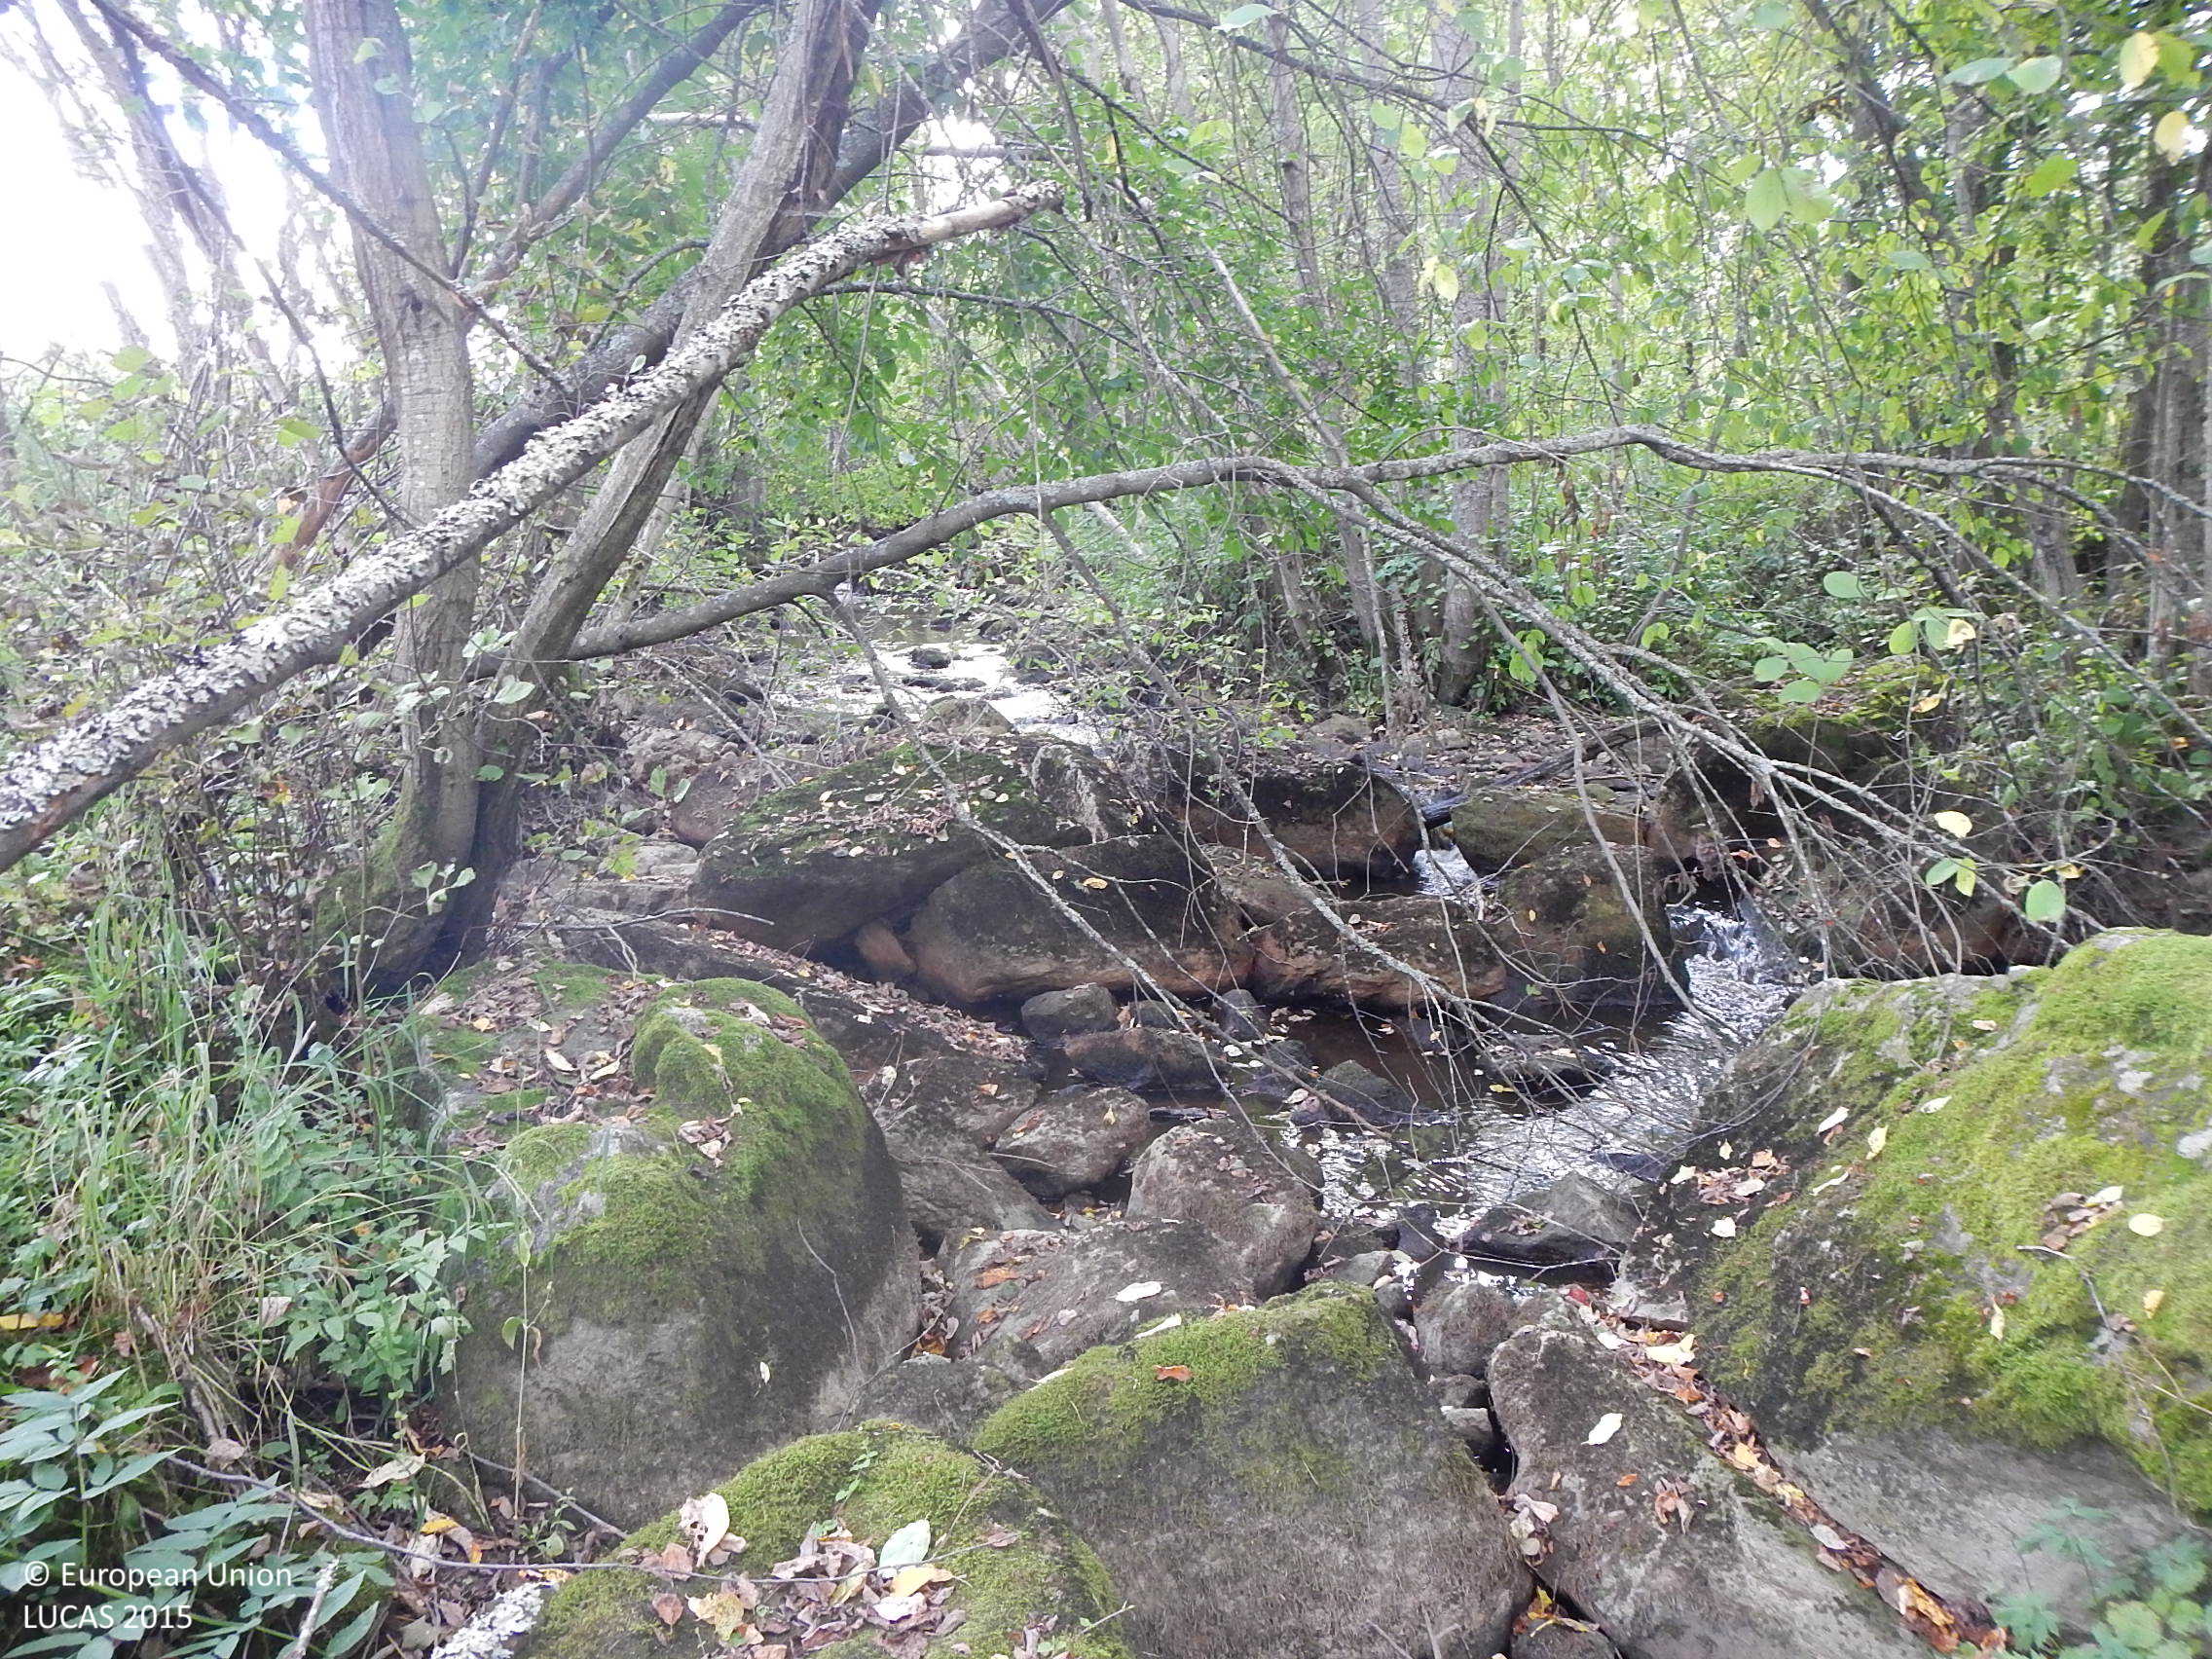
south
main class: Woodland
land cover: Broadleaved woodland
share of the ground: > 75 %
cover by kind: broadleaved forest trees 90 %, shrubs 10 %
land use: Semi-natural and natural areas not in use
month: September
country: FI
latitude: 61.4541
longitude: 22.0065
